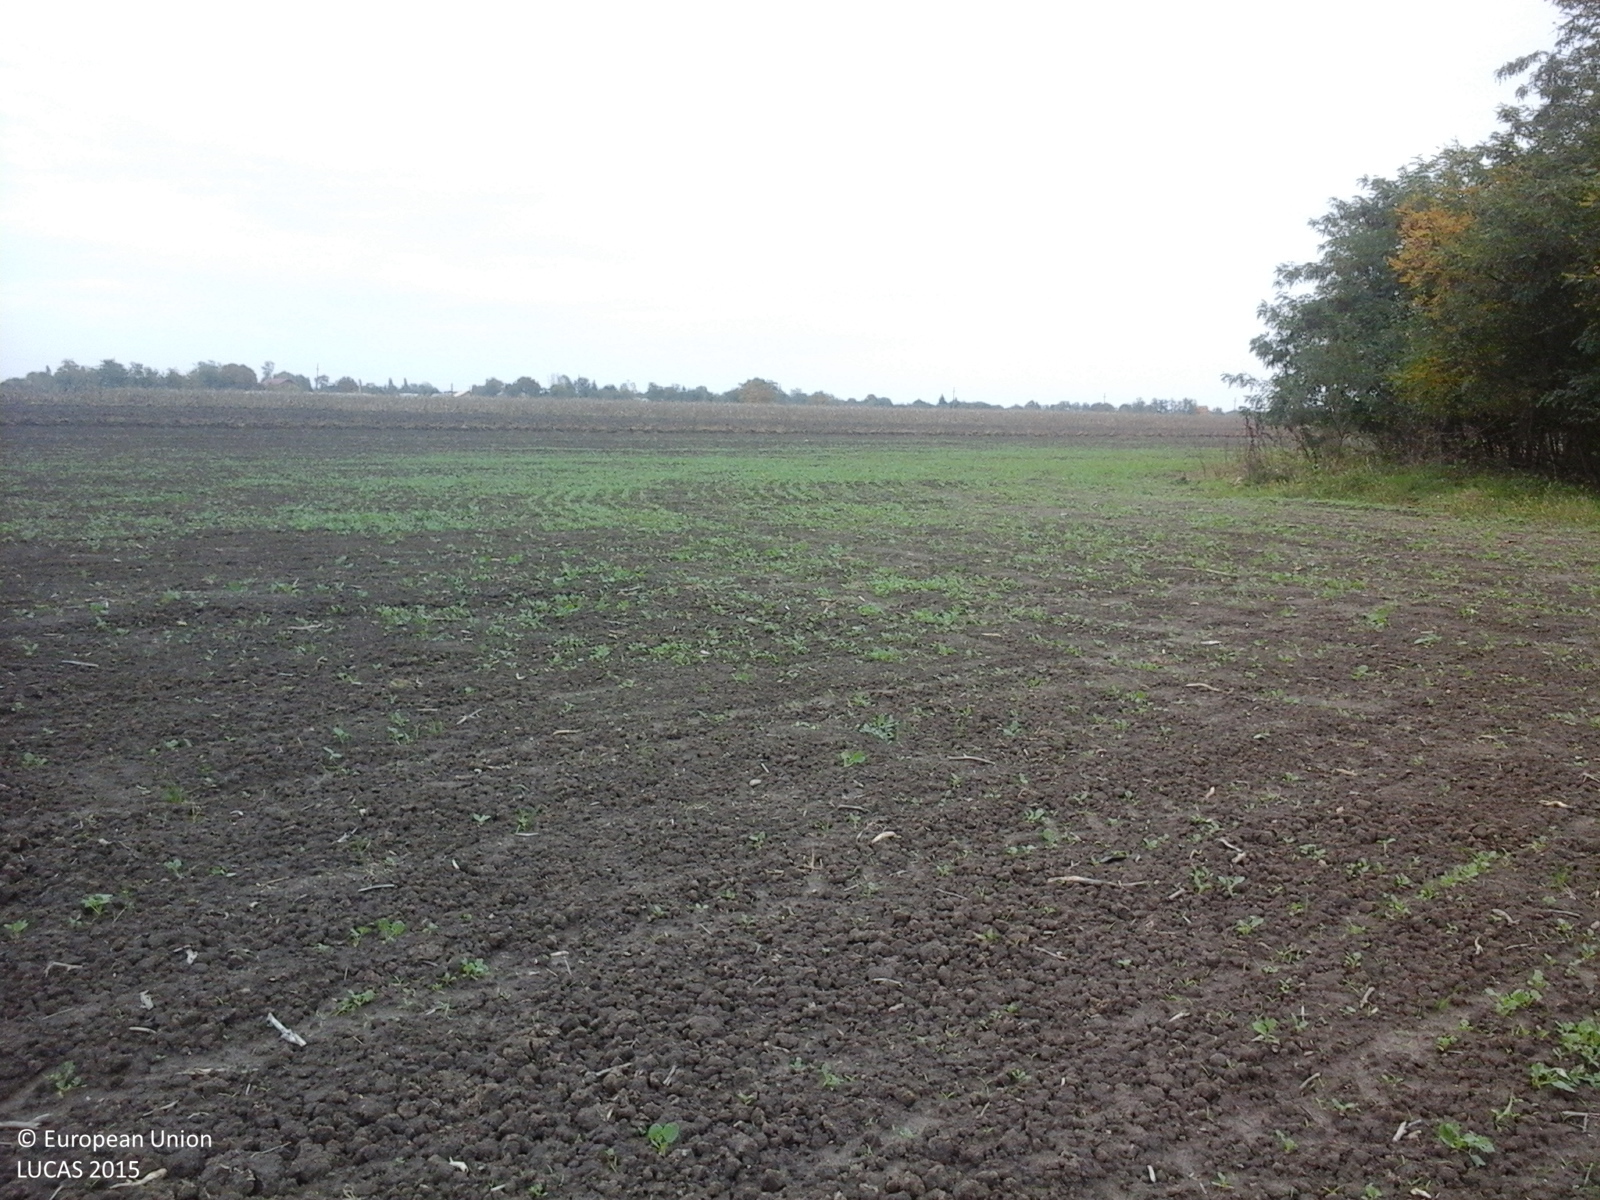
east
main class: Cropland
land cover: Rape and turnip rape
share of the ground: < 10 %
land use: Agriculture (excluding fallow land and kitchen gardens)
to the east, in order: Rape and turnip rape; Other bare soil; Maize
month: October
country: RO
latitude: 44.8459
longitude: 26.2181
